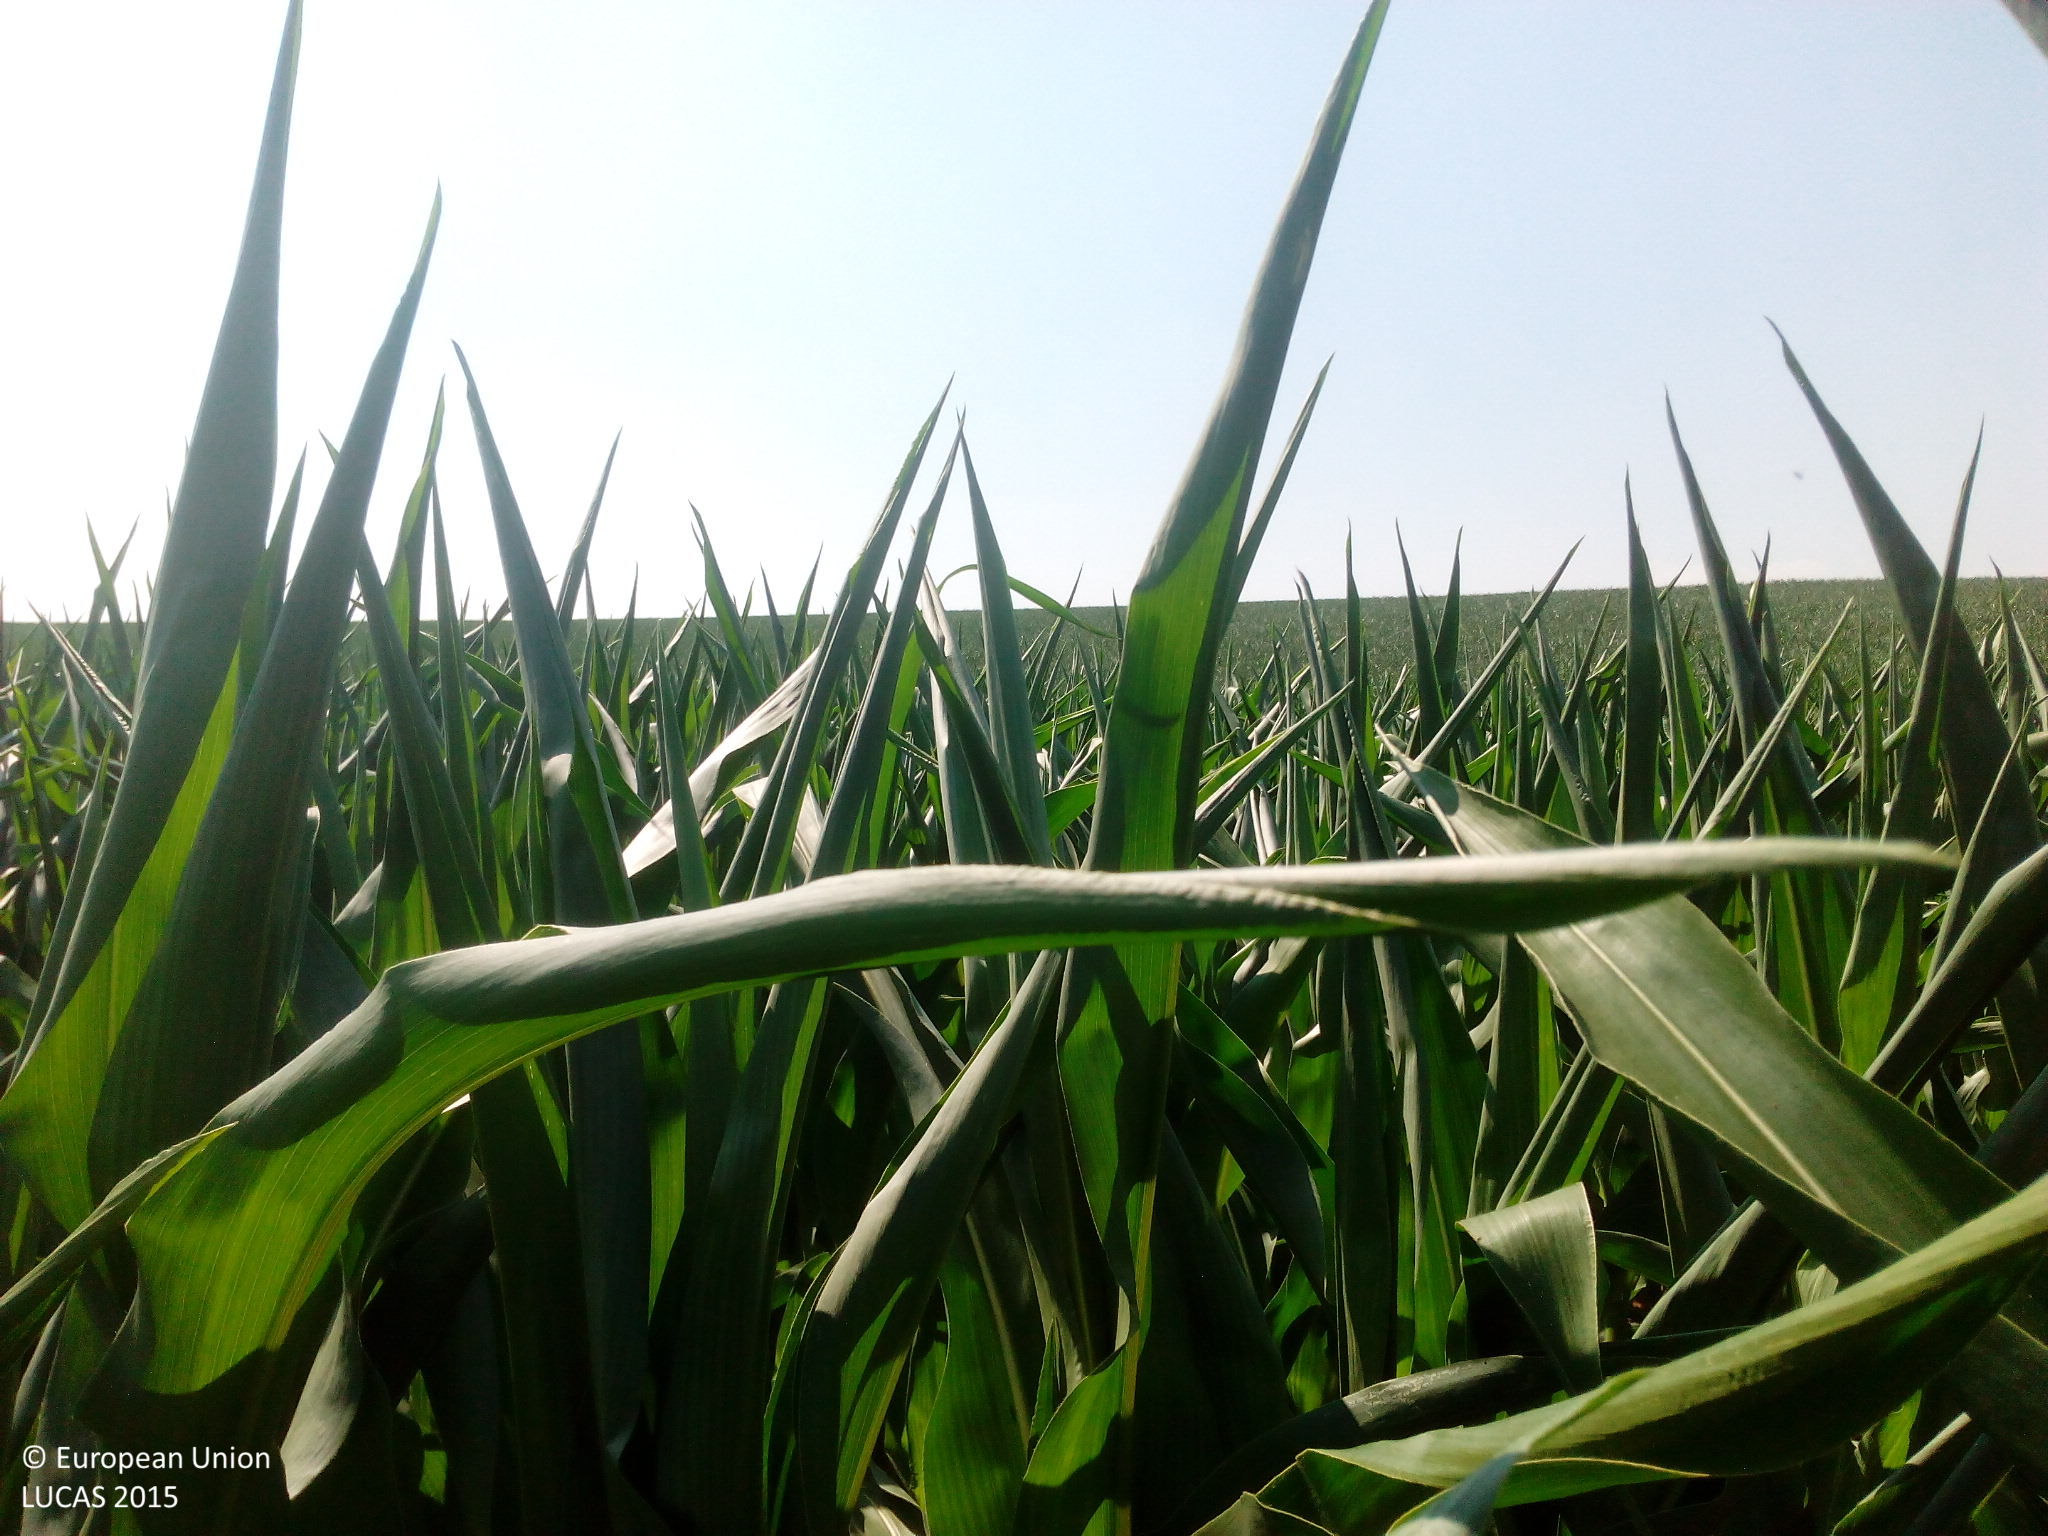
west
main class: Cropland
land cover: Maize
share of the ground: > 75 %
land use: Agriculture (excluding fallow land and kitchen gardens)
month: July
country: DE
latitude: 49.4468
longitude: 9.9035
